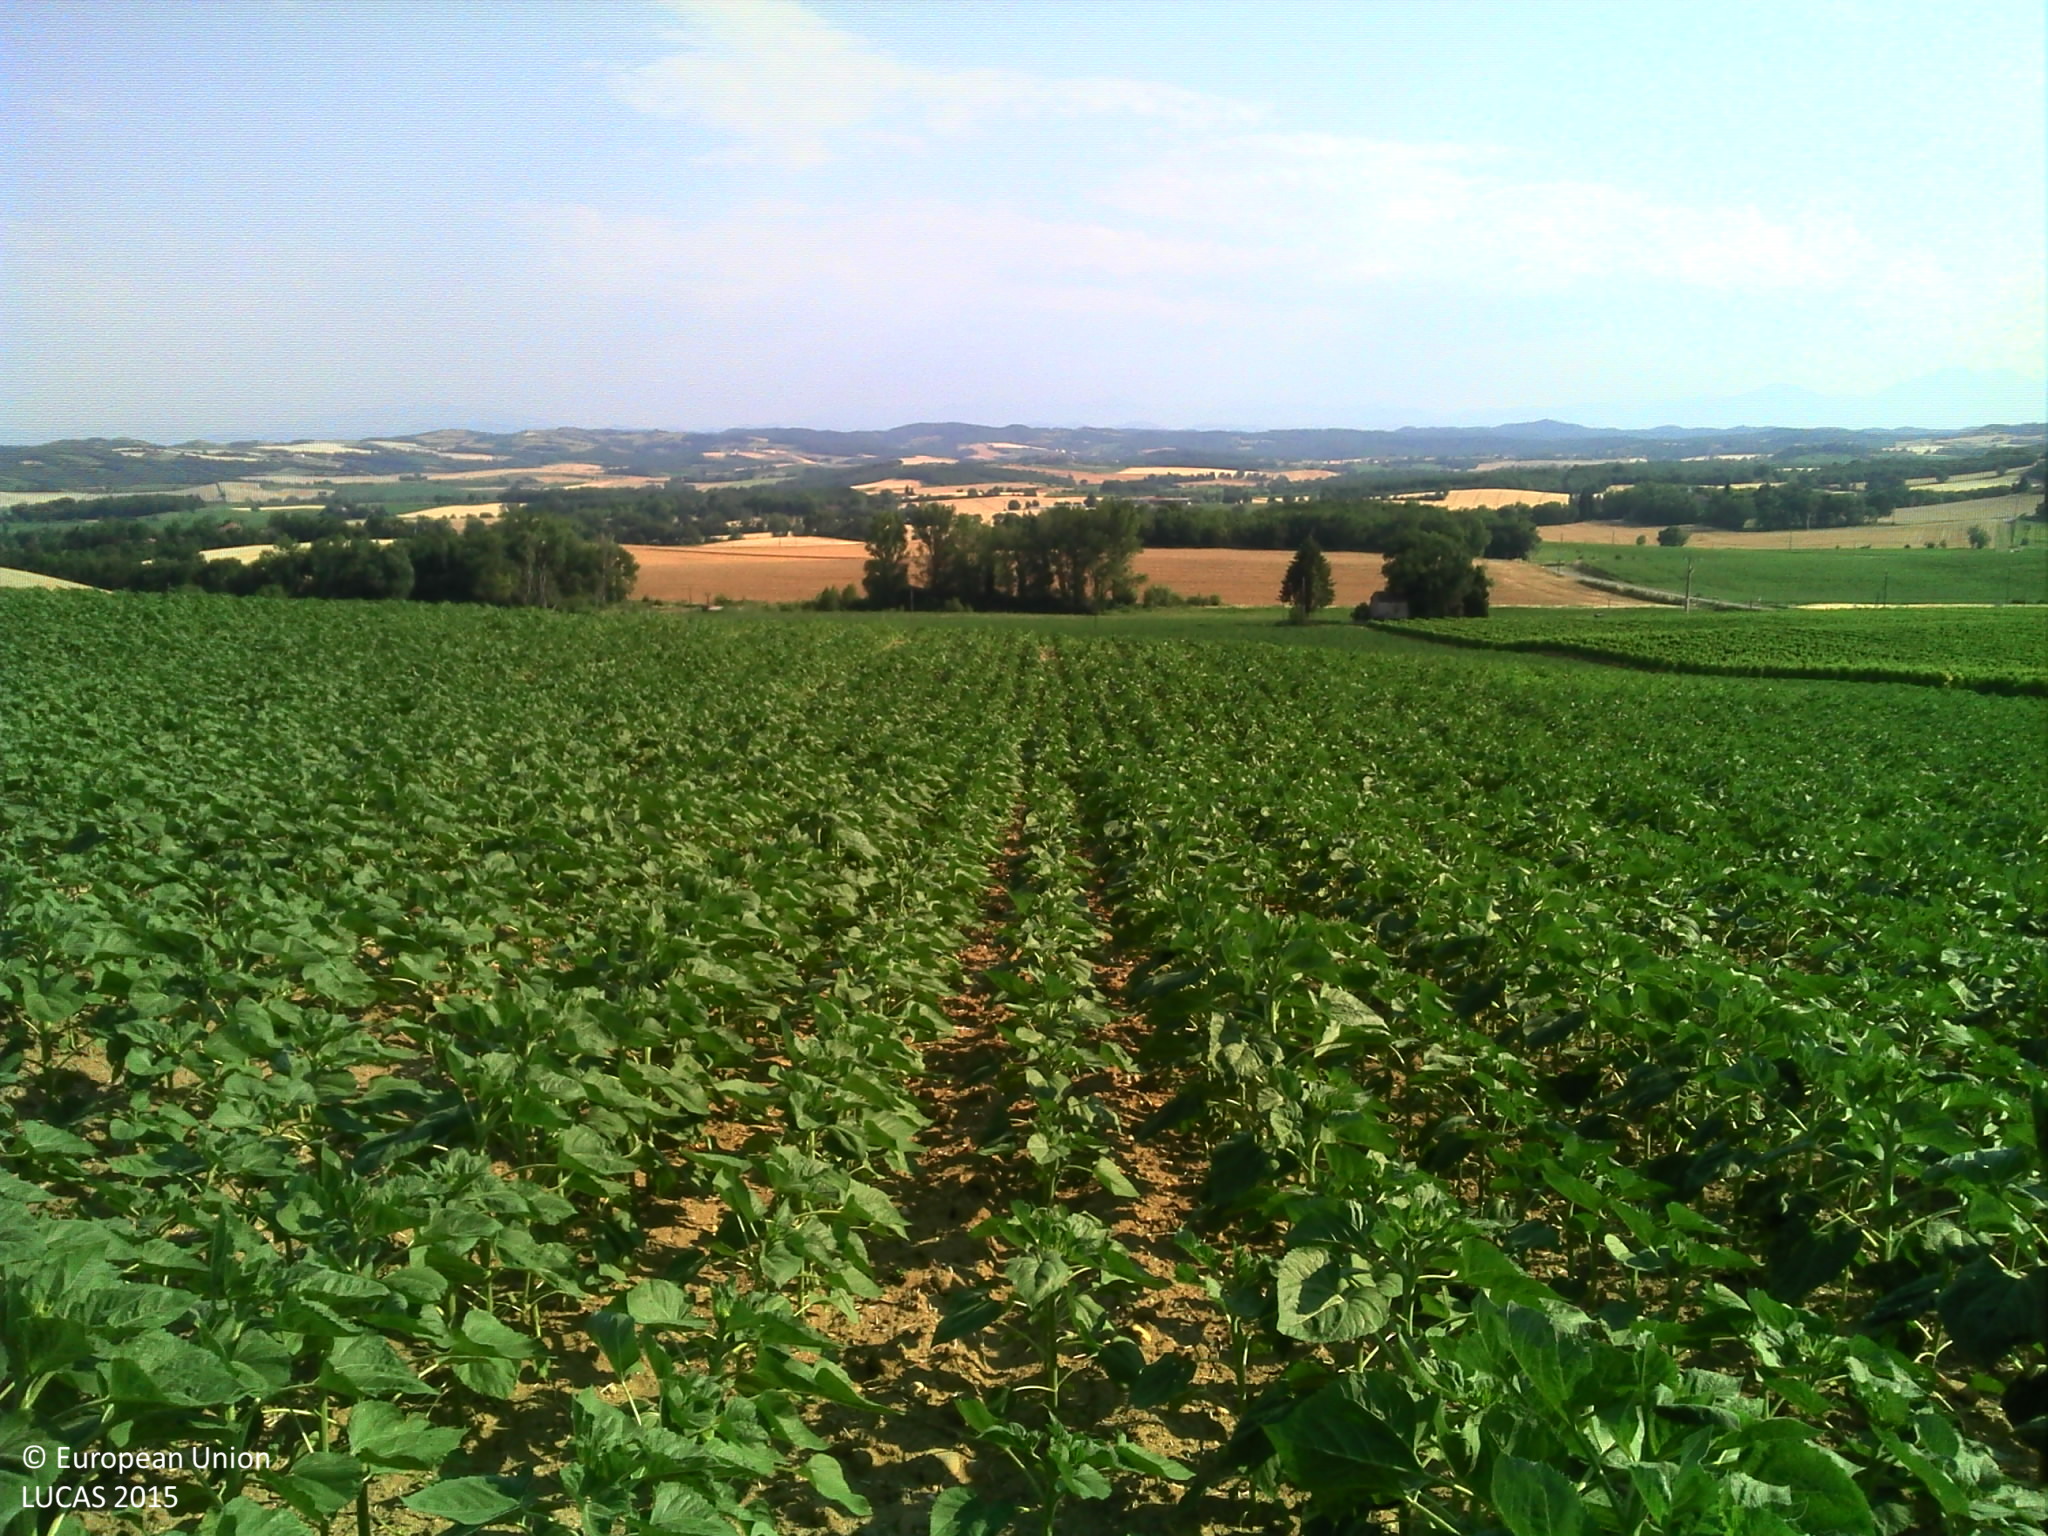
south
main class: Cropland
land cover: Sunflower
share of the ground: > 75 %
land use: Agriculture (excluding fallow land and kitchen gardens)
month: June
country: FR
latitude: 43.1572
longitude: 2.0505
